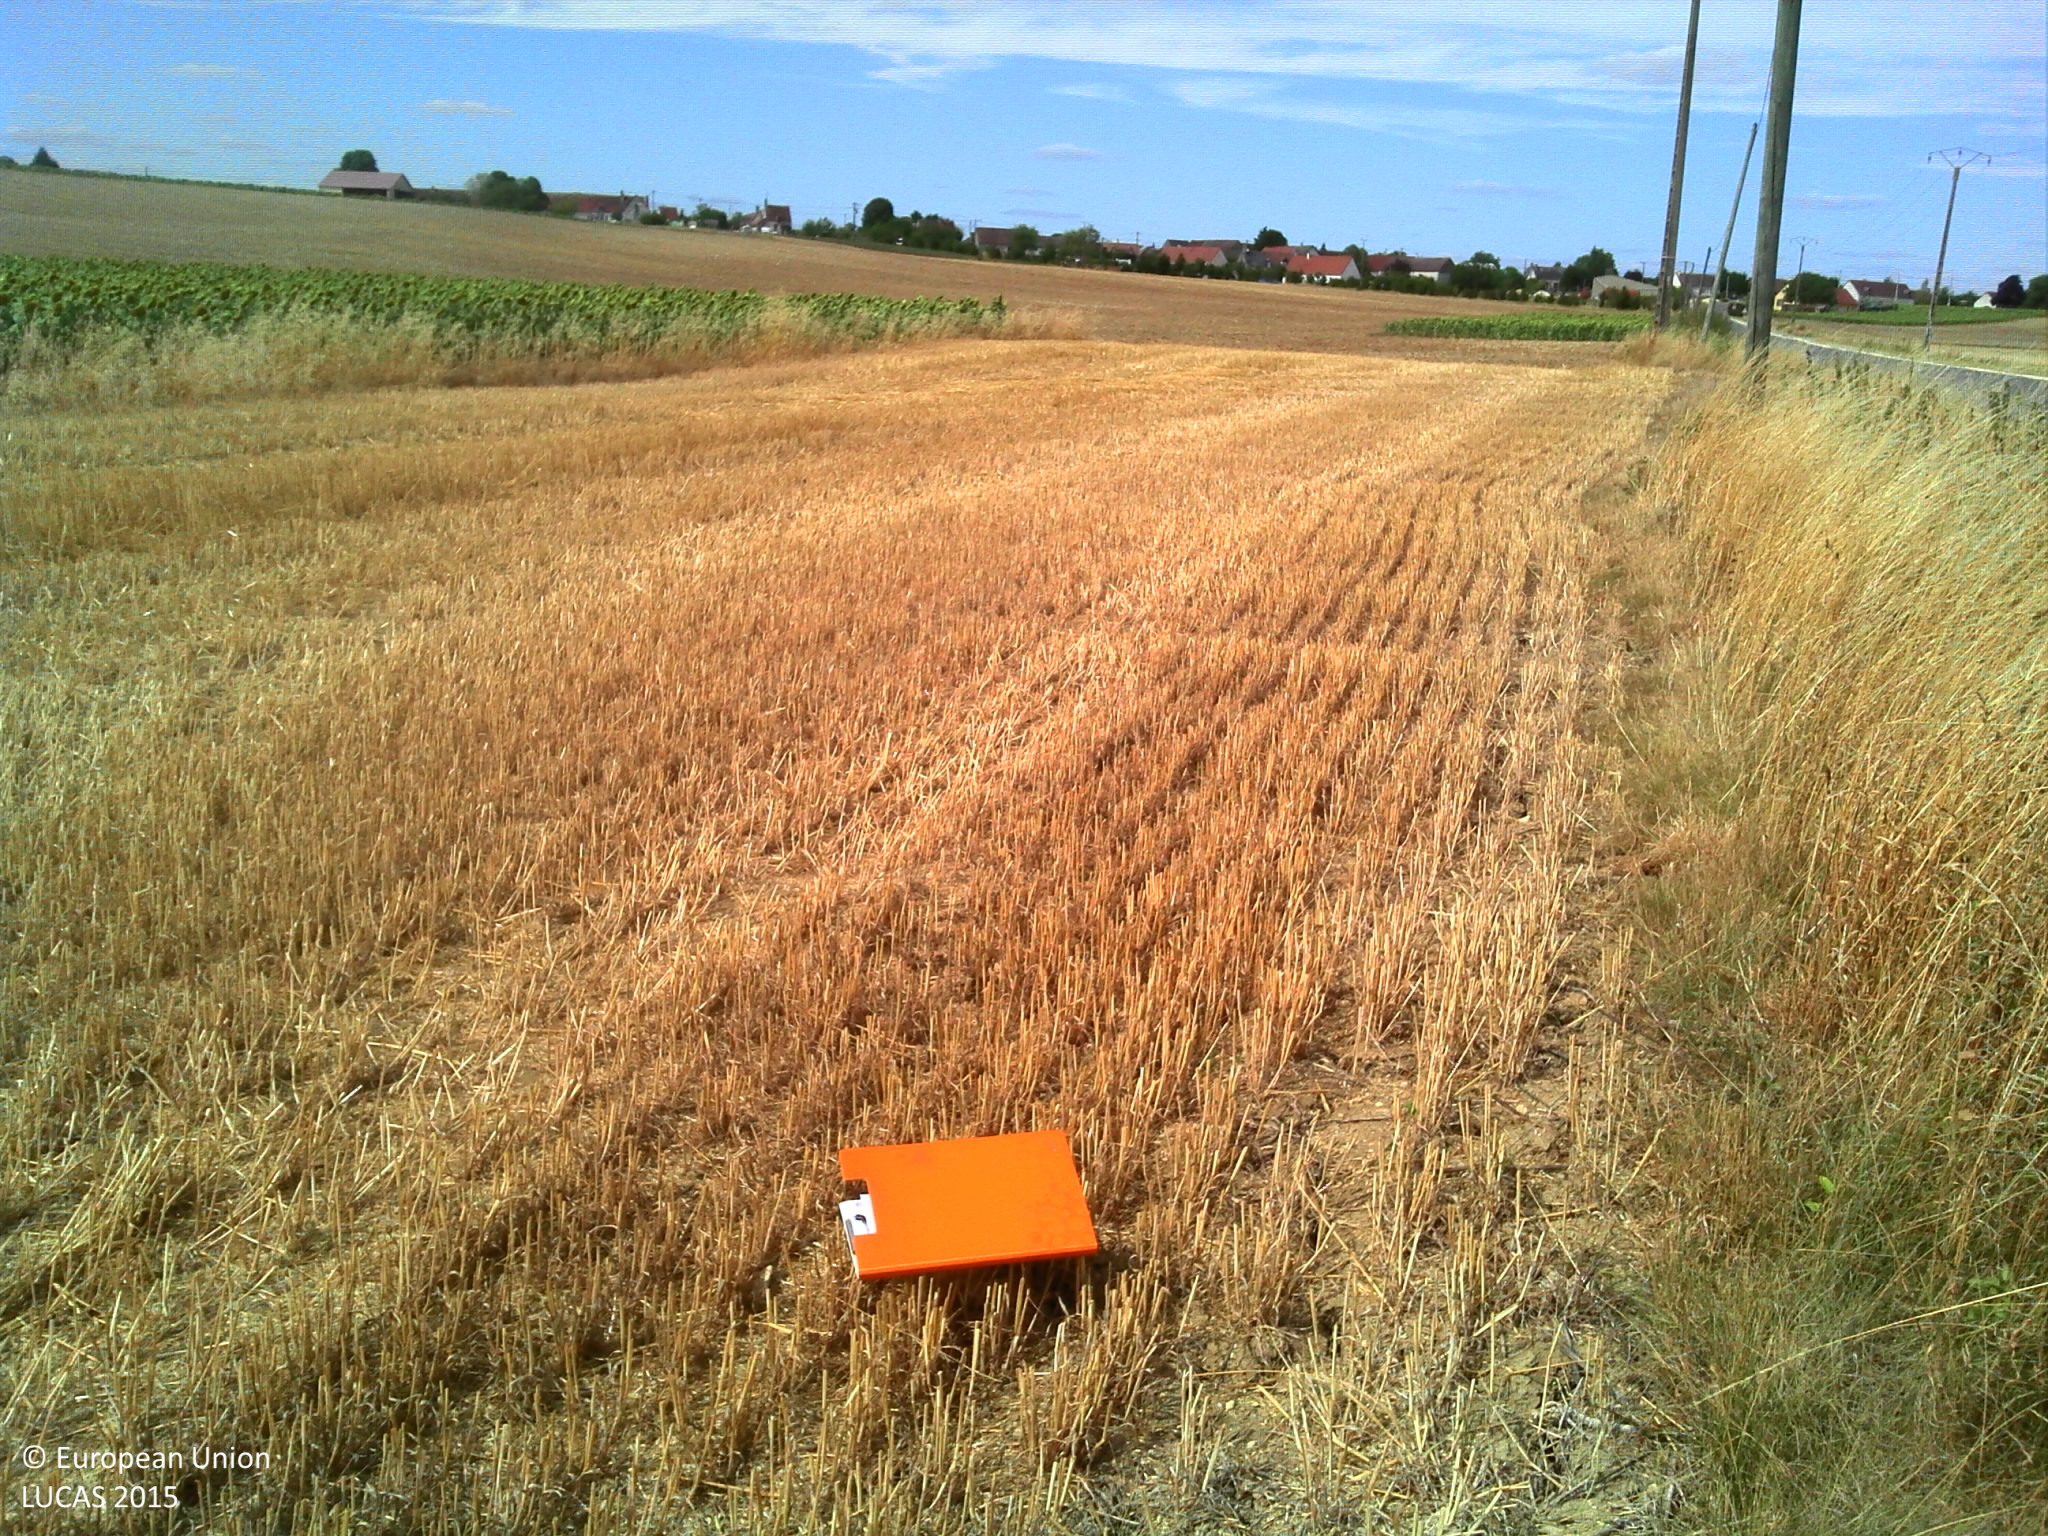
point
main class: Cropland
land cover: Common wheat
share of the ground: > 75 %
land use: Agriculture (excluding fallow land and kitchen gardens)
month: July
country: FR
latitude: 47.0382
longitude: 2.1347
